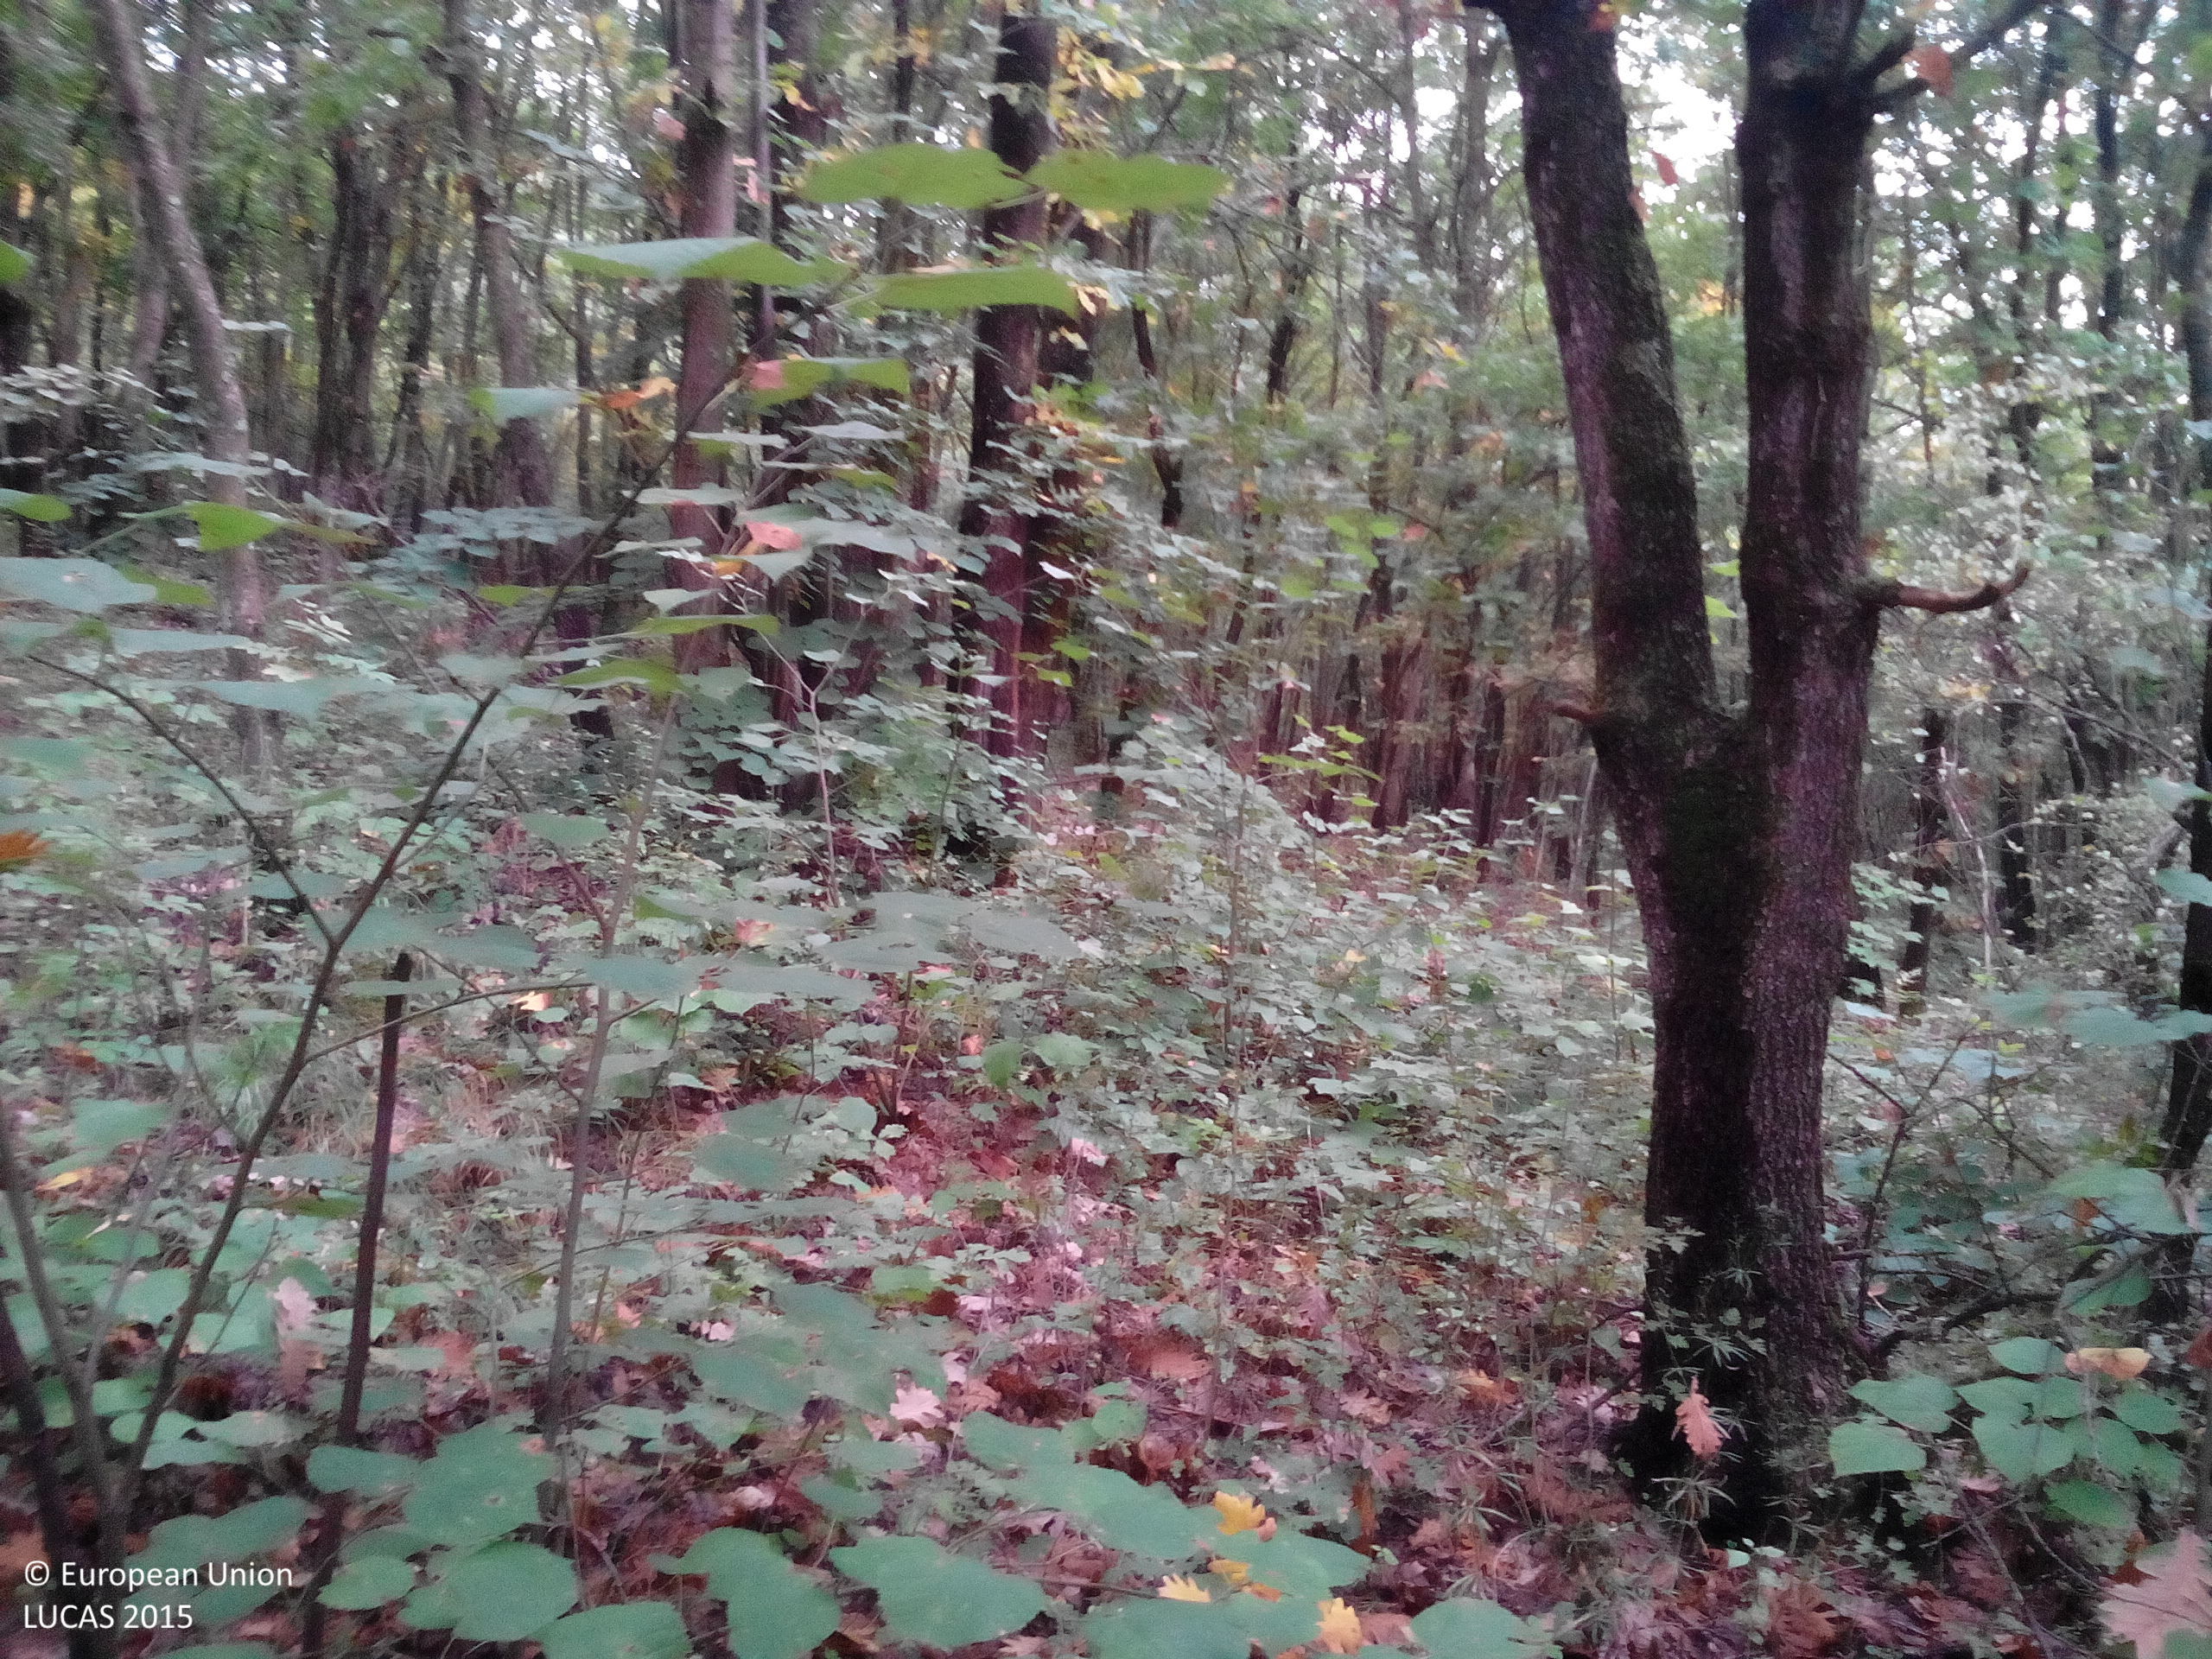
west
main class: Woodland
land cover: Broadleaved woodland
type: mesophytic deciduous forest
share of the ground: > 75 %
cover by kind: broadleaved forest trees 90 %, shrubs 5 %, herbaceous plants 5 %
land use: Forestry
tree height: > 5 m
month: October
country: BG
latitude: 43.1285
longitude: 23.9510
